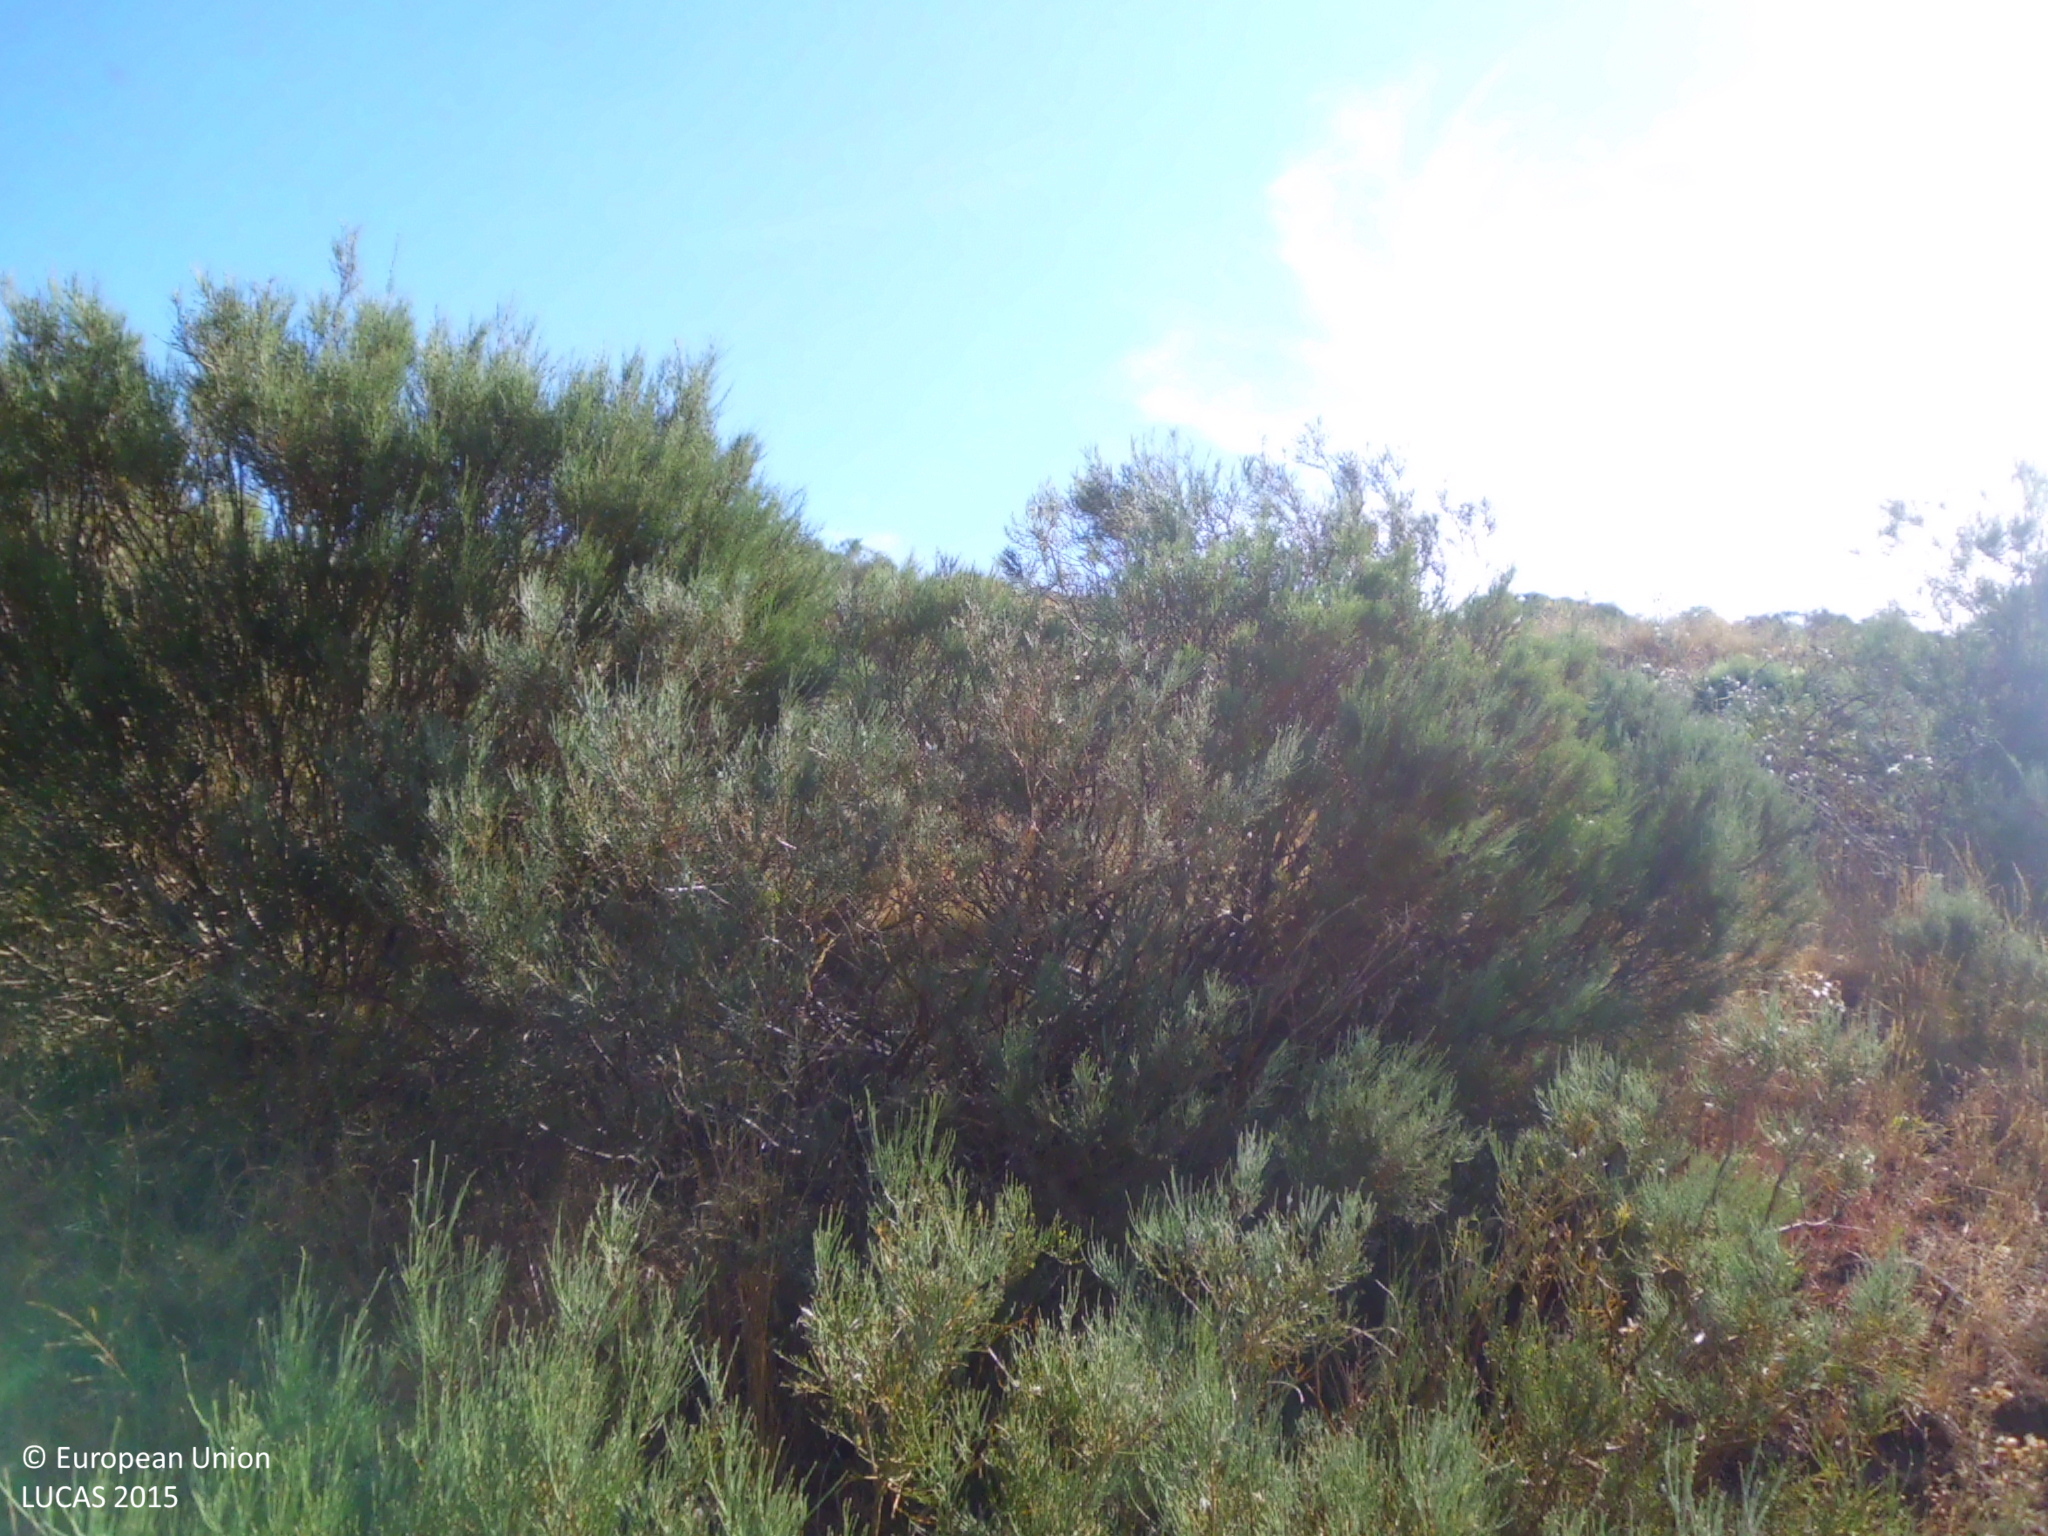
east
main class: Shrubland
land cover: Shrubland with sparse tree cover
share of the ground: > 75 %
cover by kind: shrubs 90 %, broadleaved forest trees 5 %, herbaceous plants 5 %
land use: Semi-natural and natural areas not in use
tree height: < 5 m
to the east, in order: Shrubland with sparse tree cover; Rivers and streams; Ponds and wetlands; Grassland without tree/shrub cover
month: July
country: ES
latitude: 43.0148
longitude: -4.4980
